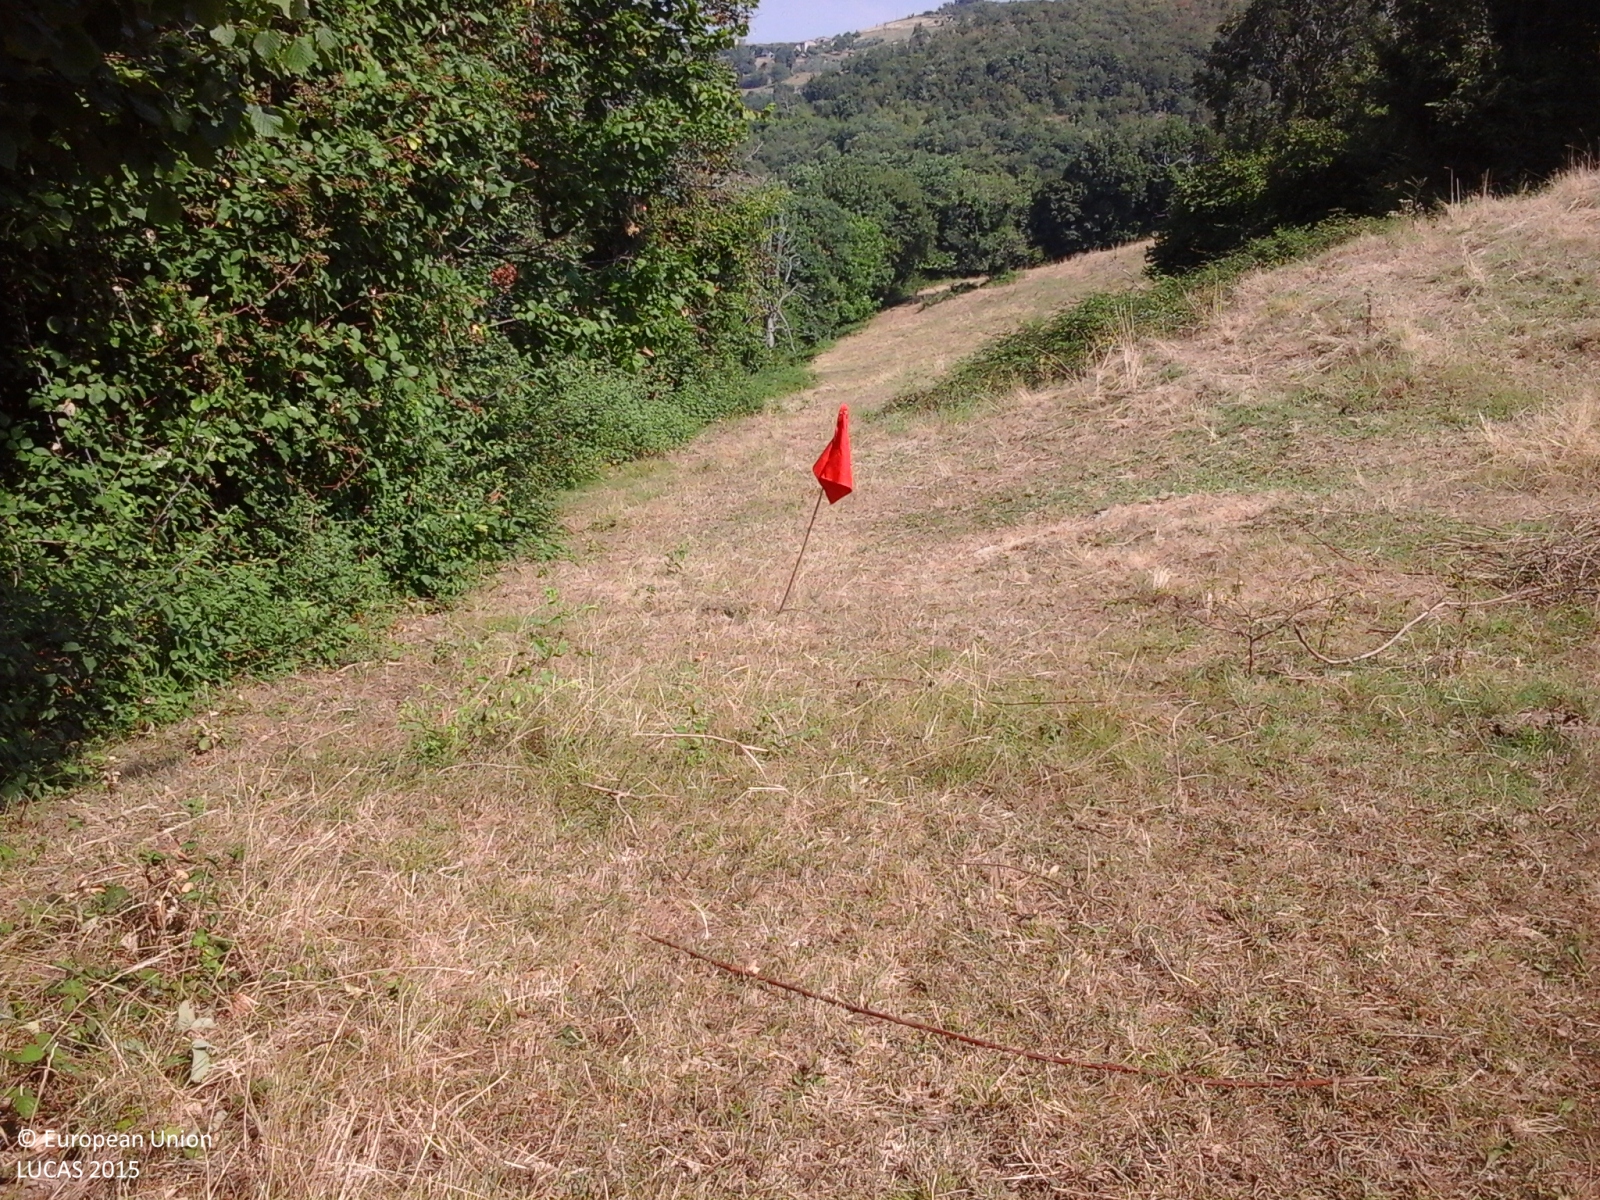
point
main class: Grassland
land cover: Grassland without tree/shrub cover
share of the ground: > 75 %
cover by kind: herbaceous plants 100 %
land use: Agriculture (excluding fallow land and kitchen gardens)
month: July
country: IT
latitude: 45.5346
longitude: 11.1122
